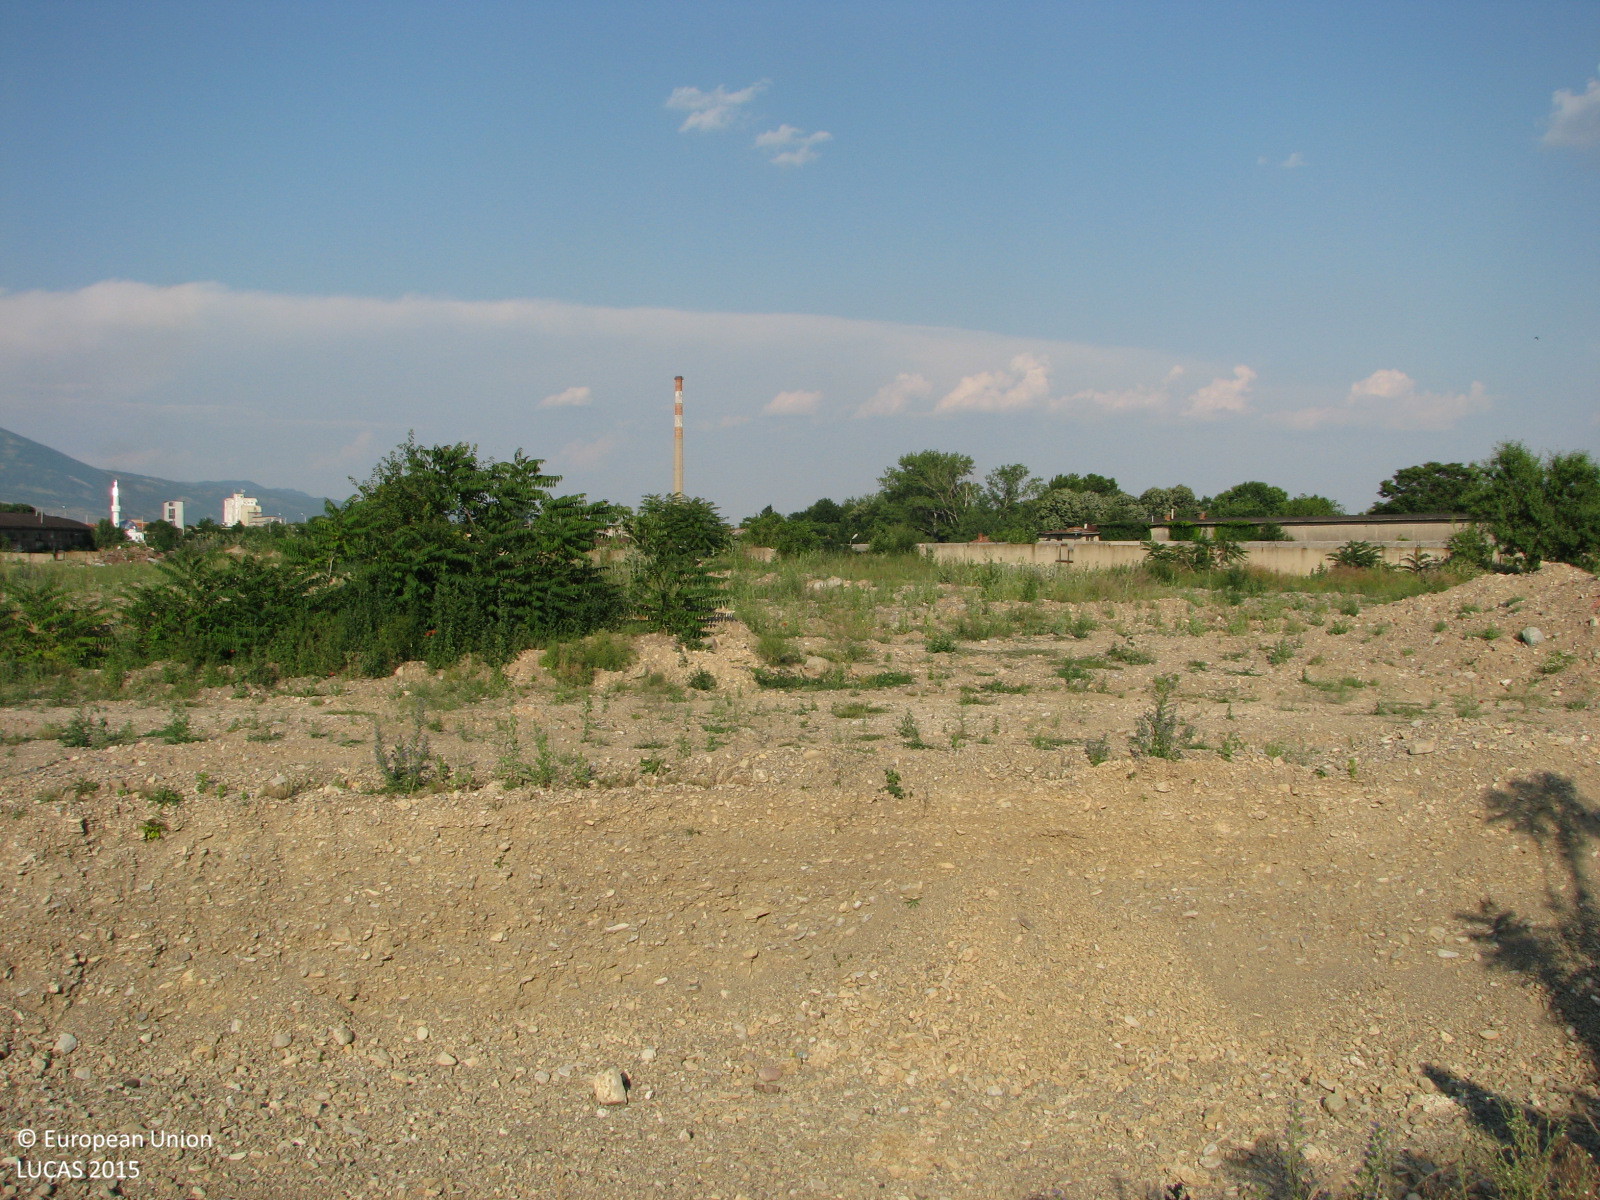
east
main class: Grassland
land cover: Grassland with sparse tree/shrub cover
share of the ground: > 75 %
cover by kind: herbaceous plants 90 %, broadleaved forest trees 5 %, shrubs 5 %
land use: Abandoned areas
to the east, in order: Grassland with sparse tree/shrub cover; Artificial constructions in urban areas; Grassland with sparse tree/shrub cover; Fences; Grassland without tree/shrub cover; Railways; Grassland without tree/shrub cover; Artificial constructions in urban areas; Shrubland without tree cover; Artificial constructions in urban areas; Shrubland without tree cover; Fences; Grassland with sparse tree/shrub cover
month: June
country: BG
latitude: 42.6607
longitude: 26.3283
